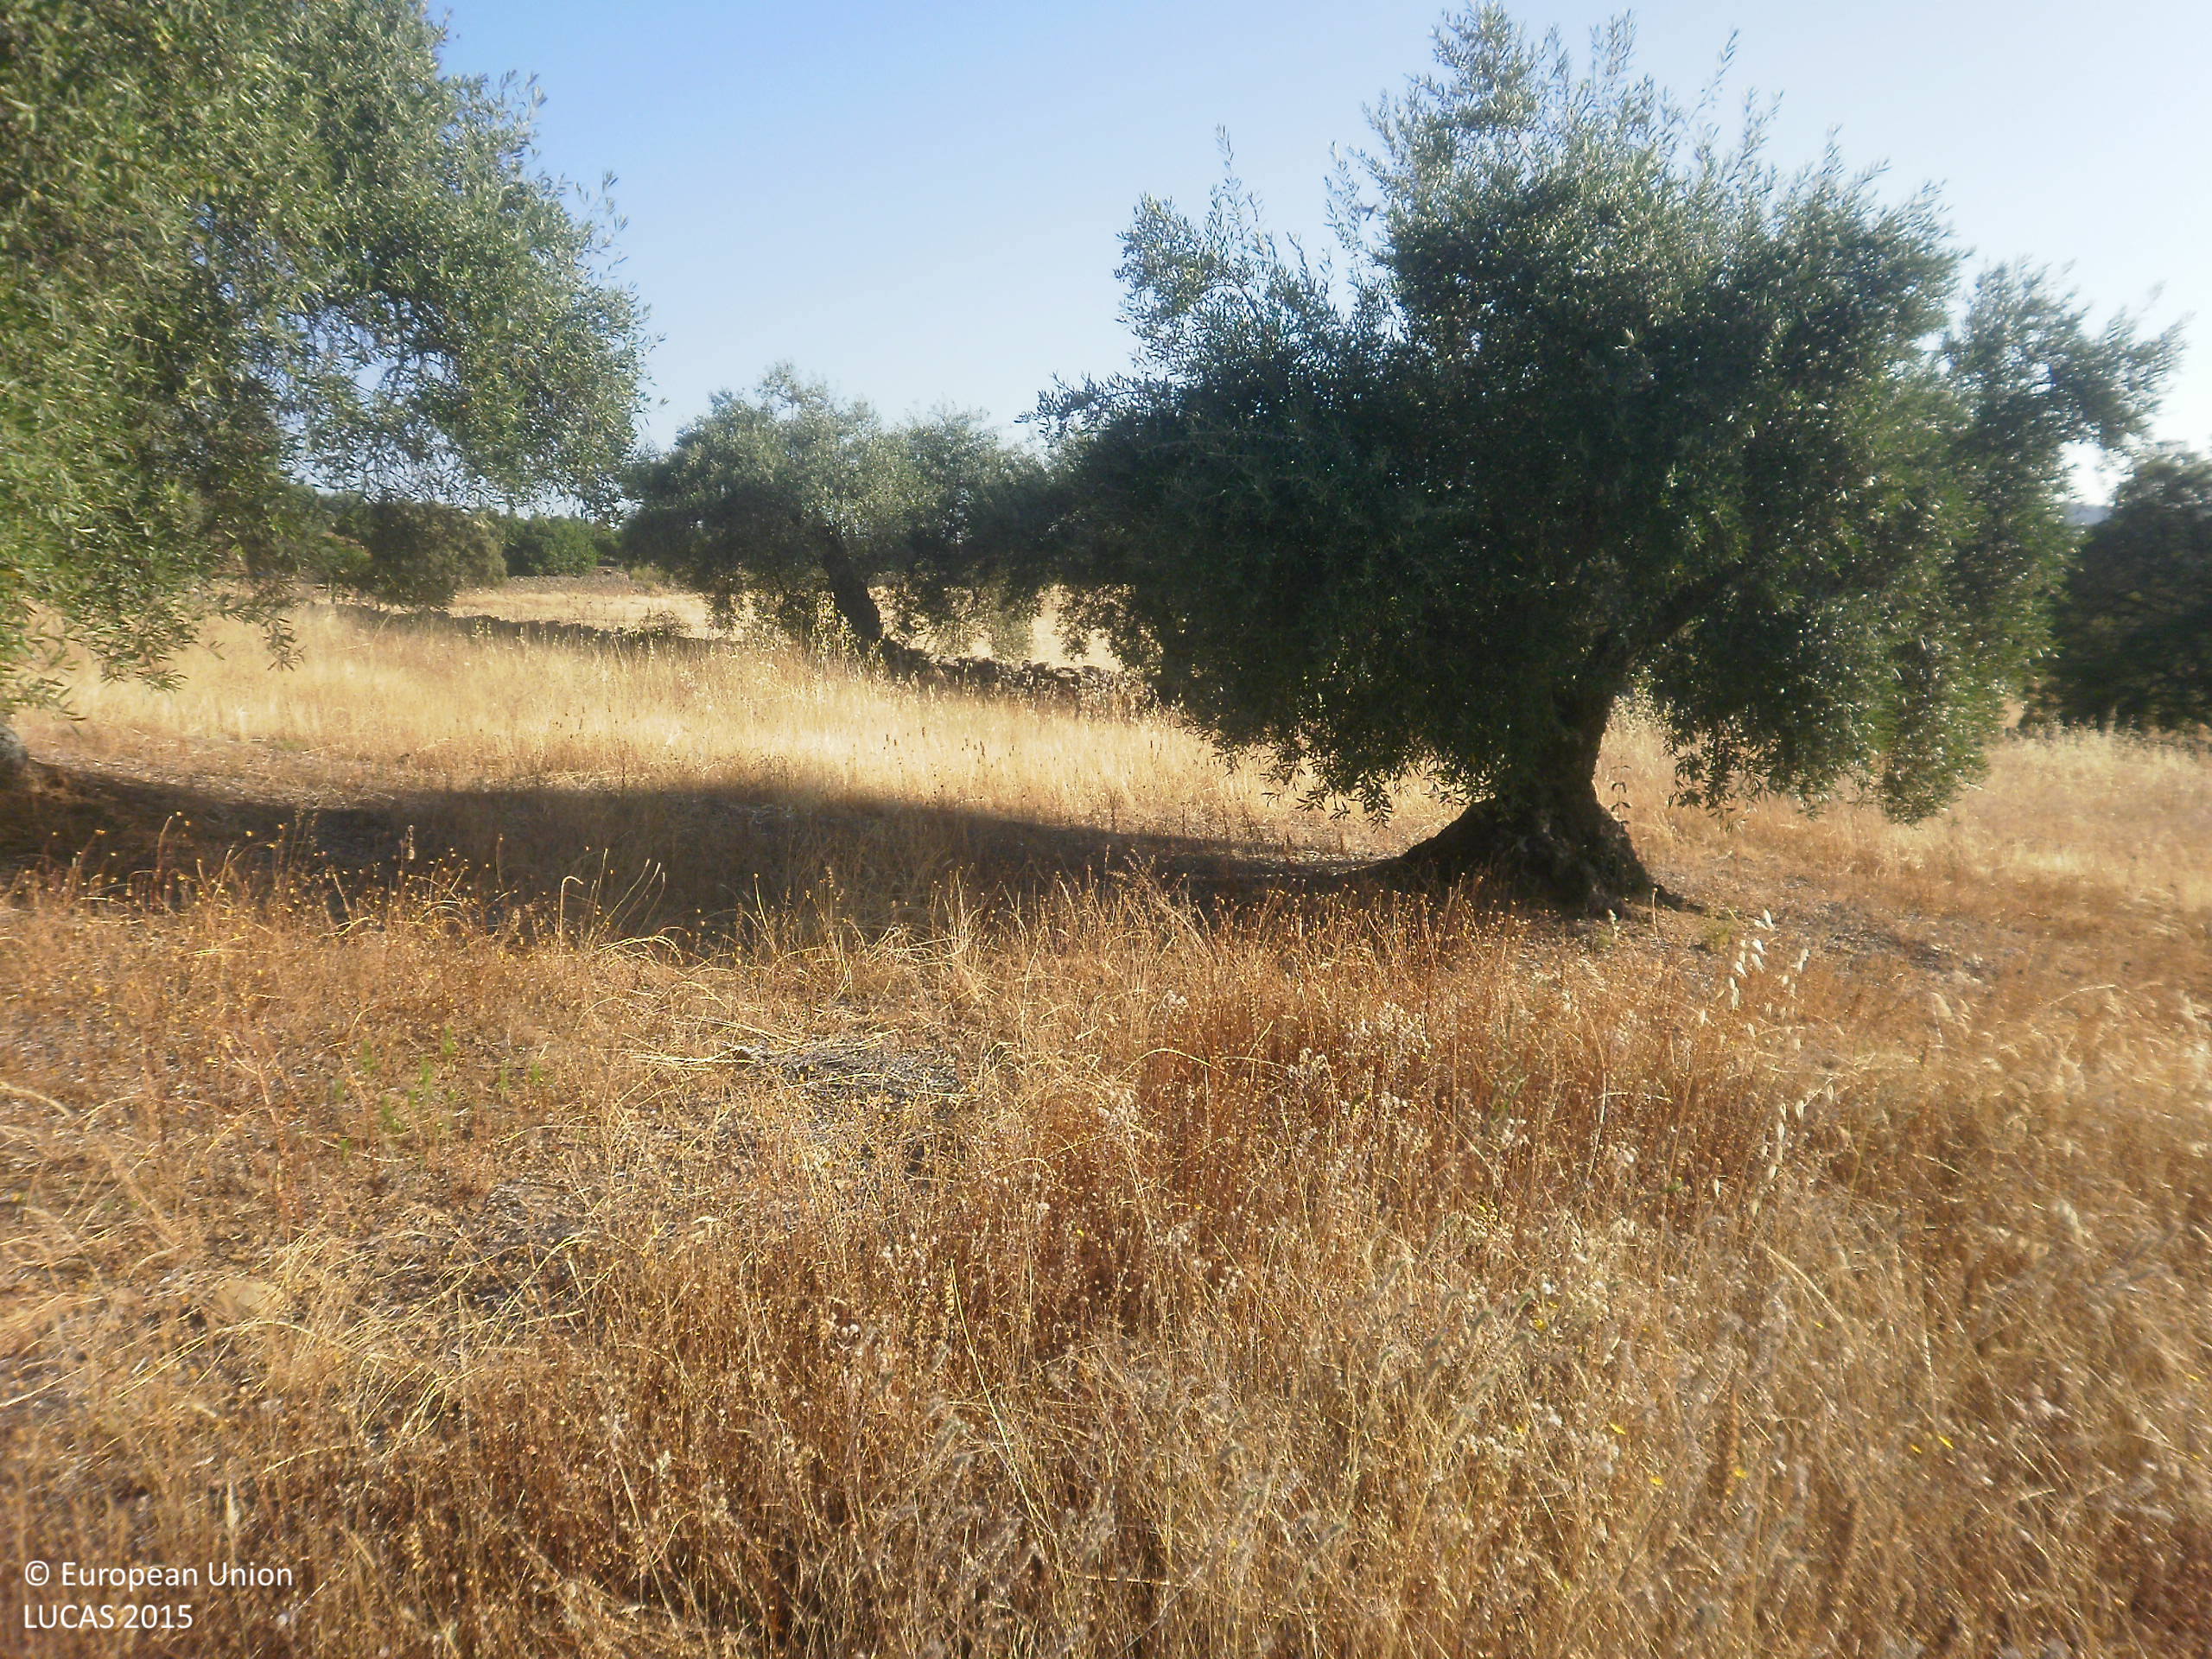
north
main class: Cropland
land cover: Olive groves
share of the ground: 50 - 75 %
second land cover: Grassland without tree/shrub cover
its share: 25 - 50 %
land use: Agriculture (excluding fallow land and kitchen gardens)
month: June
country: ES
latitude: 39.2513
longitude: -6.0371
